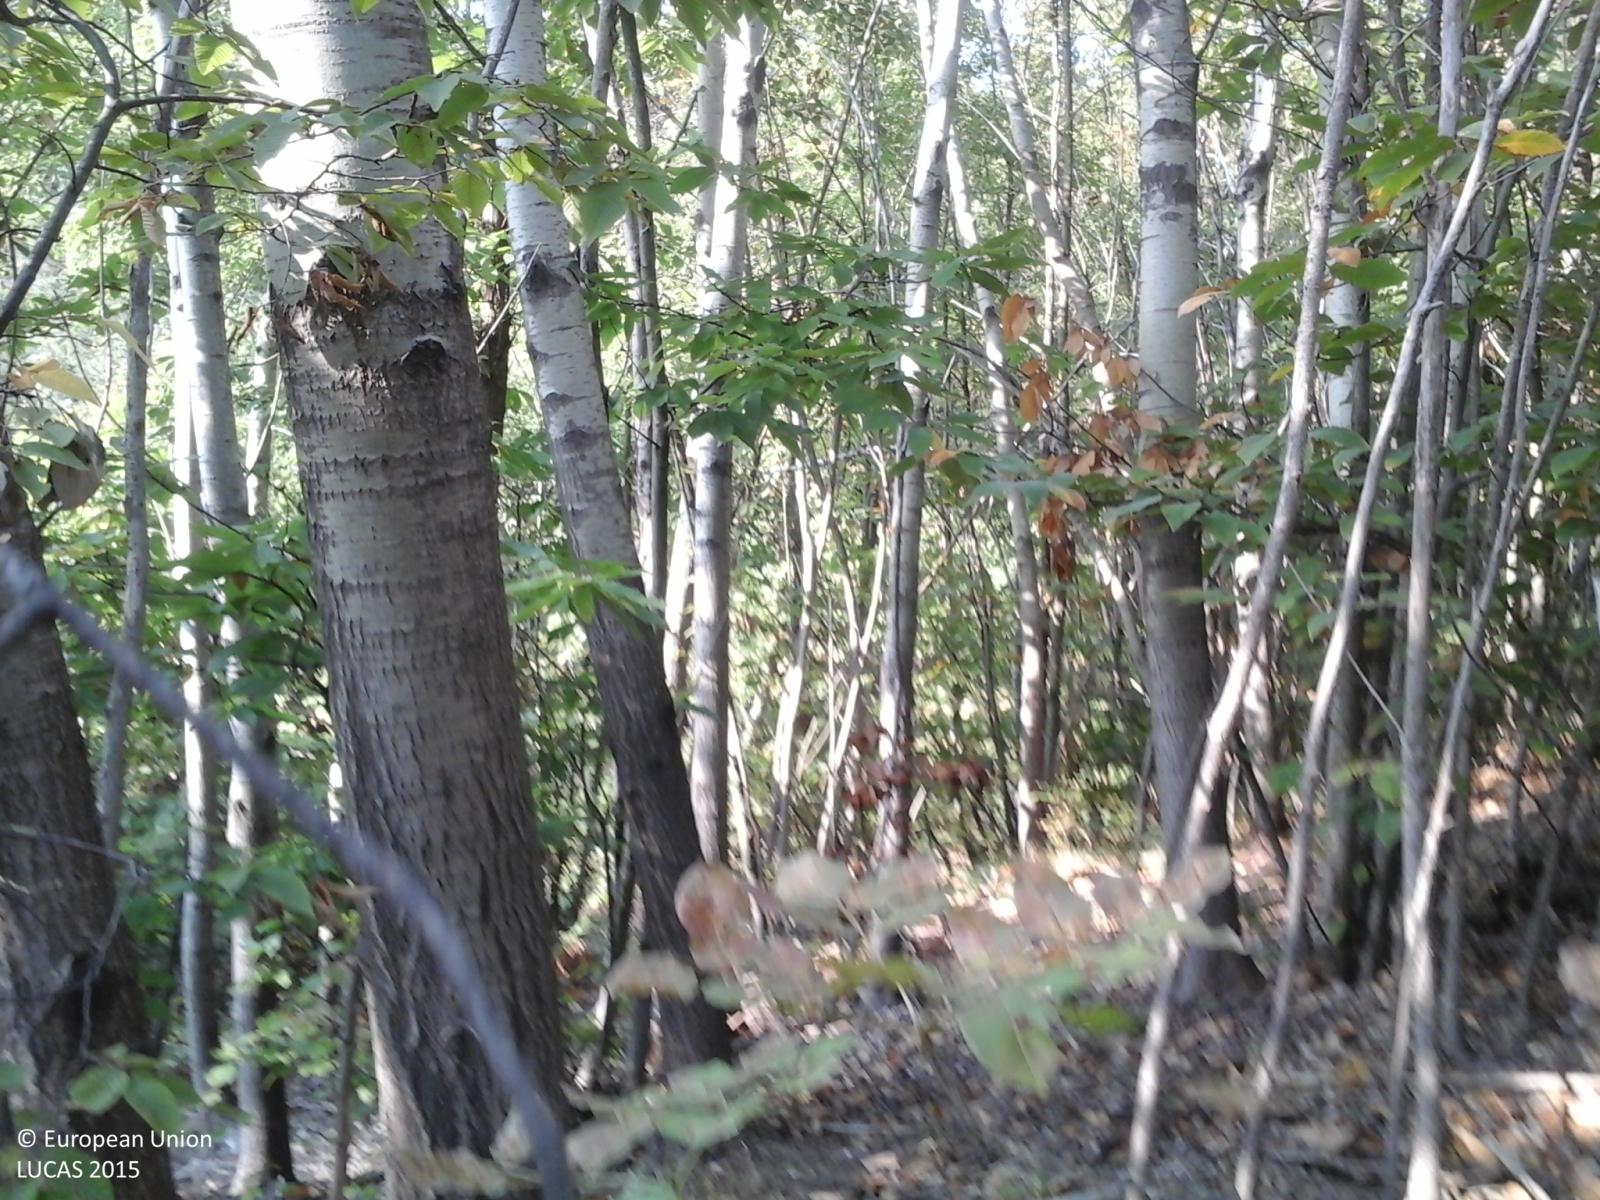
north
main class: Woodland
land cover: Broadleaved woodland
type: thermophilous deciduous forest
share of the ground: > 75 %
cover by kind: broadleaved forest trees 90 %, herbaceous plants 10 %
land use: Forestry
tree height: > 5 m
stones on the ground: 10 - 25 %
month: September
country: IT
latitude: 44.3360
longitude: 8.2606
